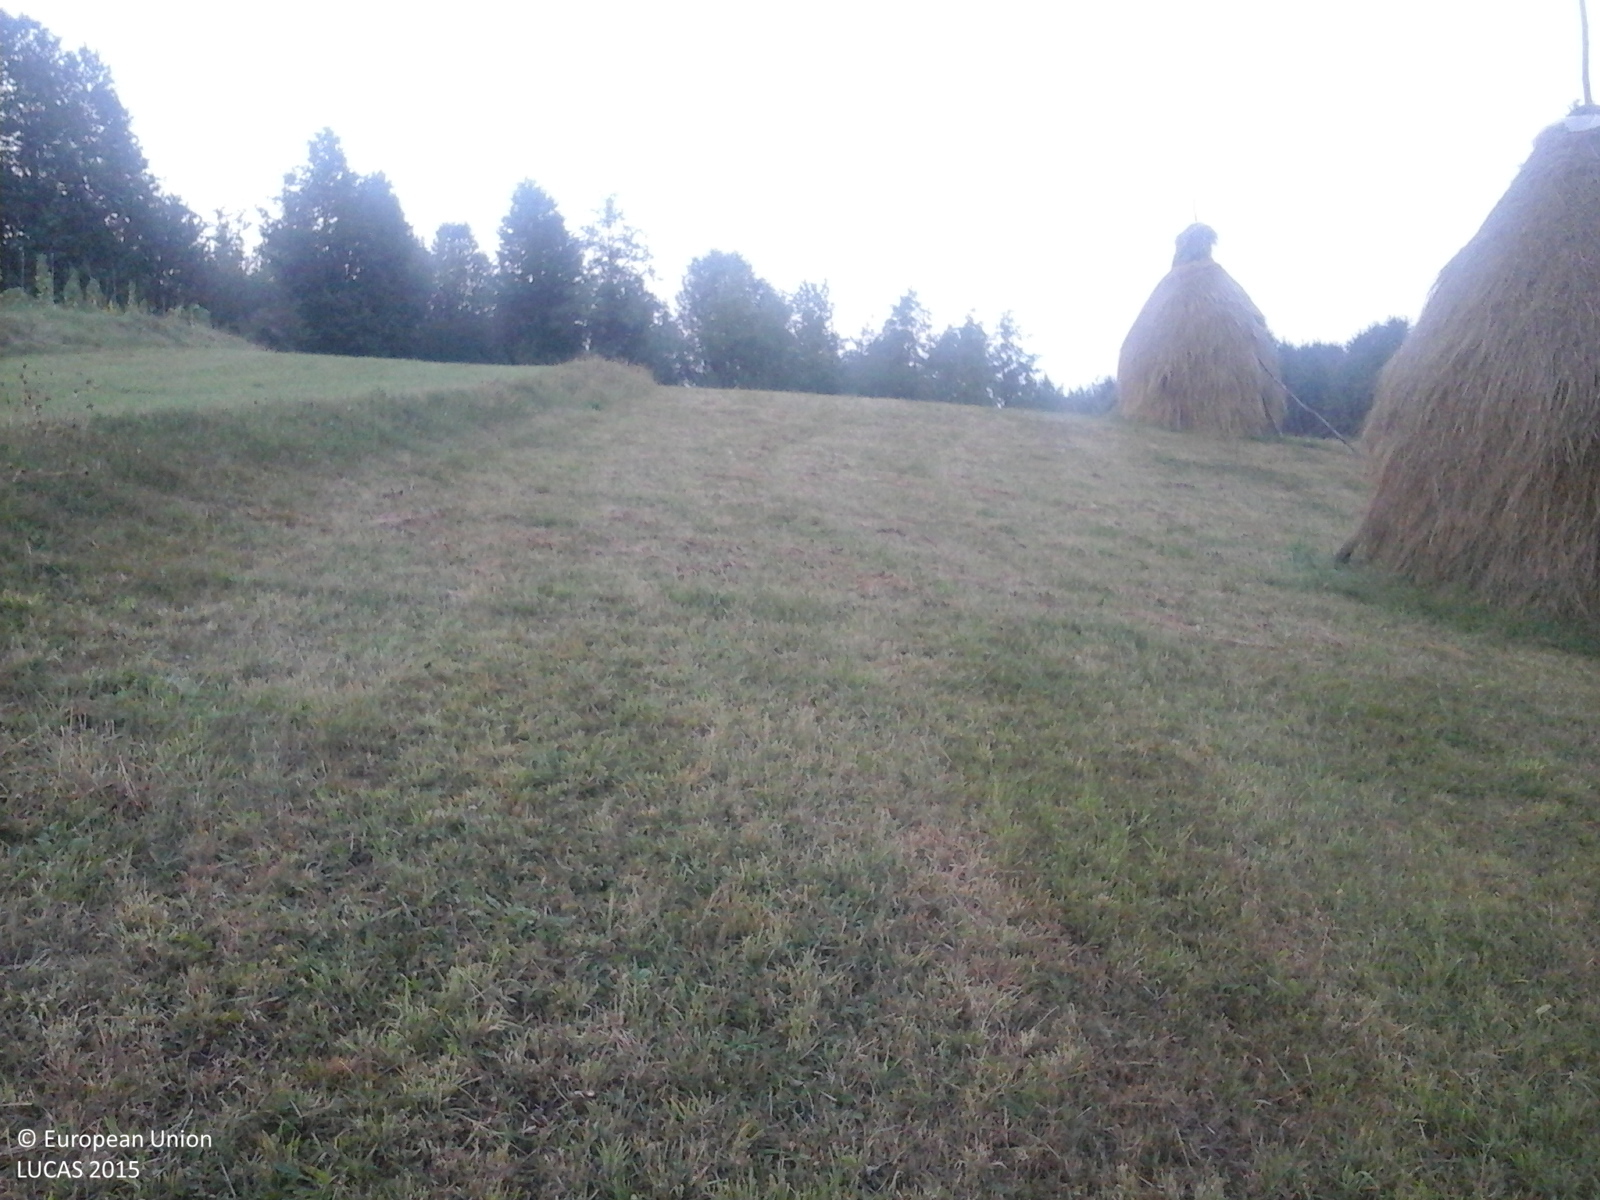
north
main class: Grassland
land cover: Grassland without tree/shrub cover
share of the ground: > 75 %
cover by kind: herbaceous plants 100 %
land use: Agriculture (excluding fallow land and kitchen gardens)
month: September
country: RO
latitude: 47.7554
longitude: 23.9166
